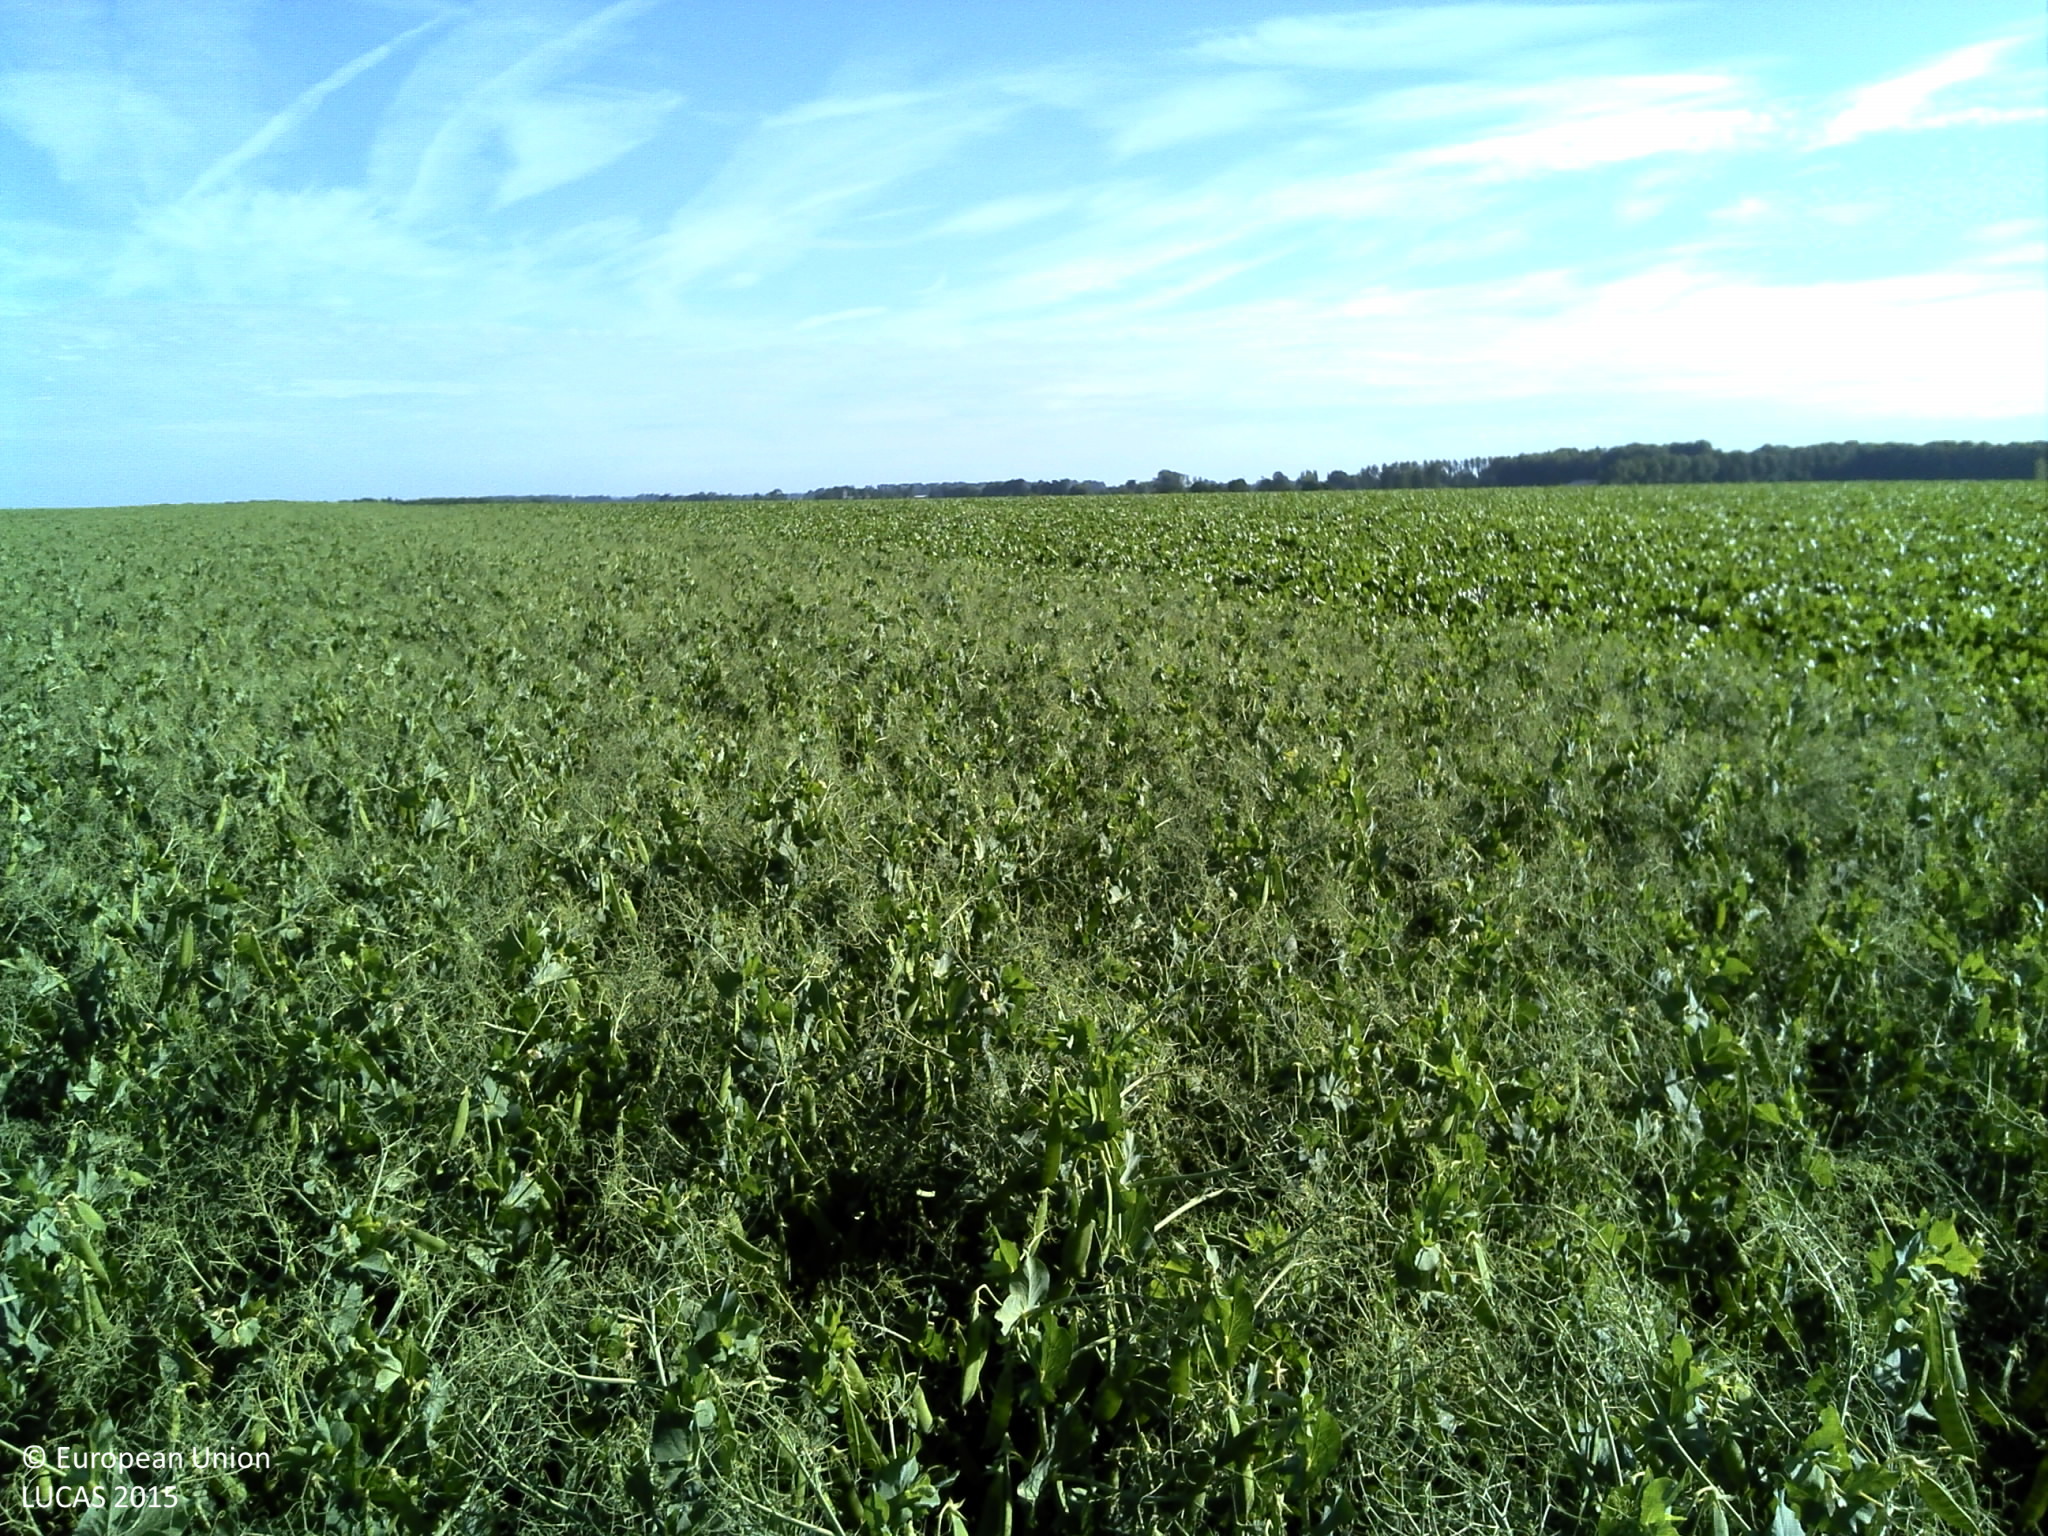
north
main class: Cropland
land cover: Dry pulses
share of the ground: > 75 %
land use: Agriculture (excluding fallow land and kitchen gardens)
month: June
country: FR
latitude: 49.7751
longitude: 1.0209
